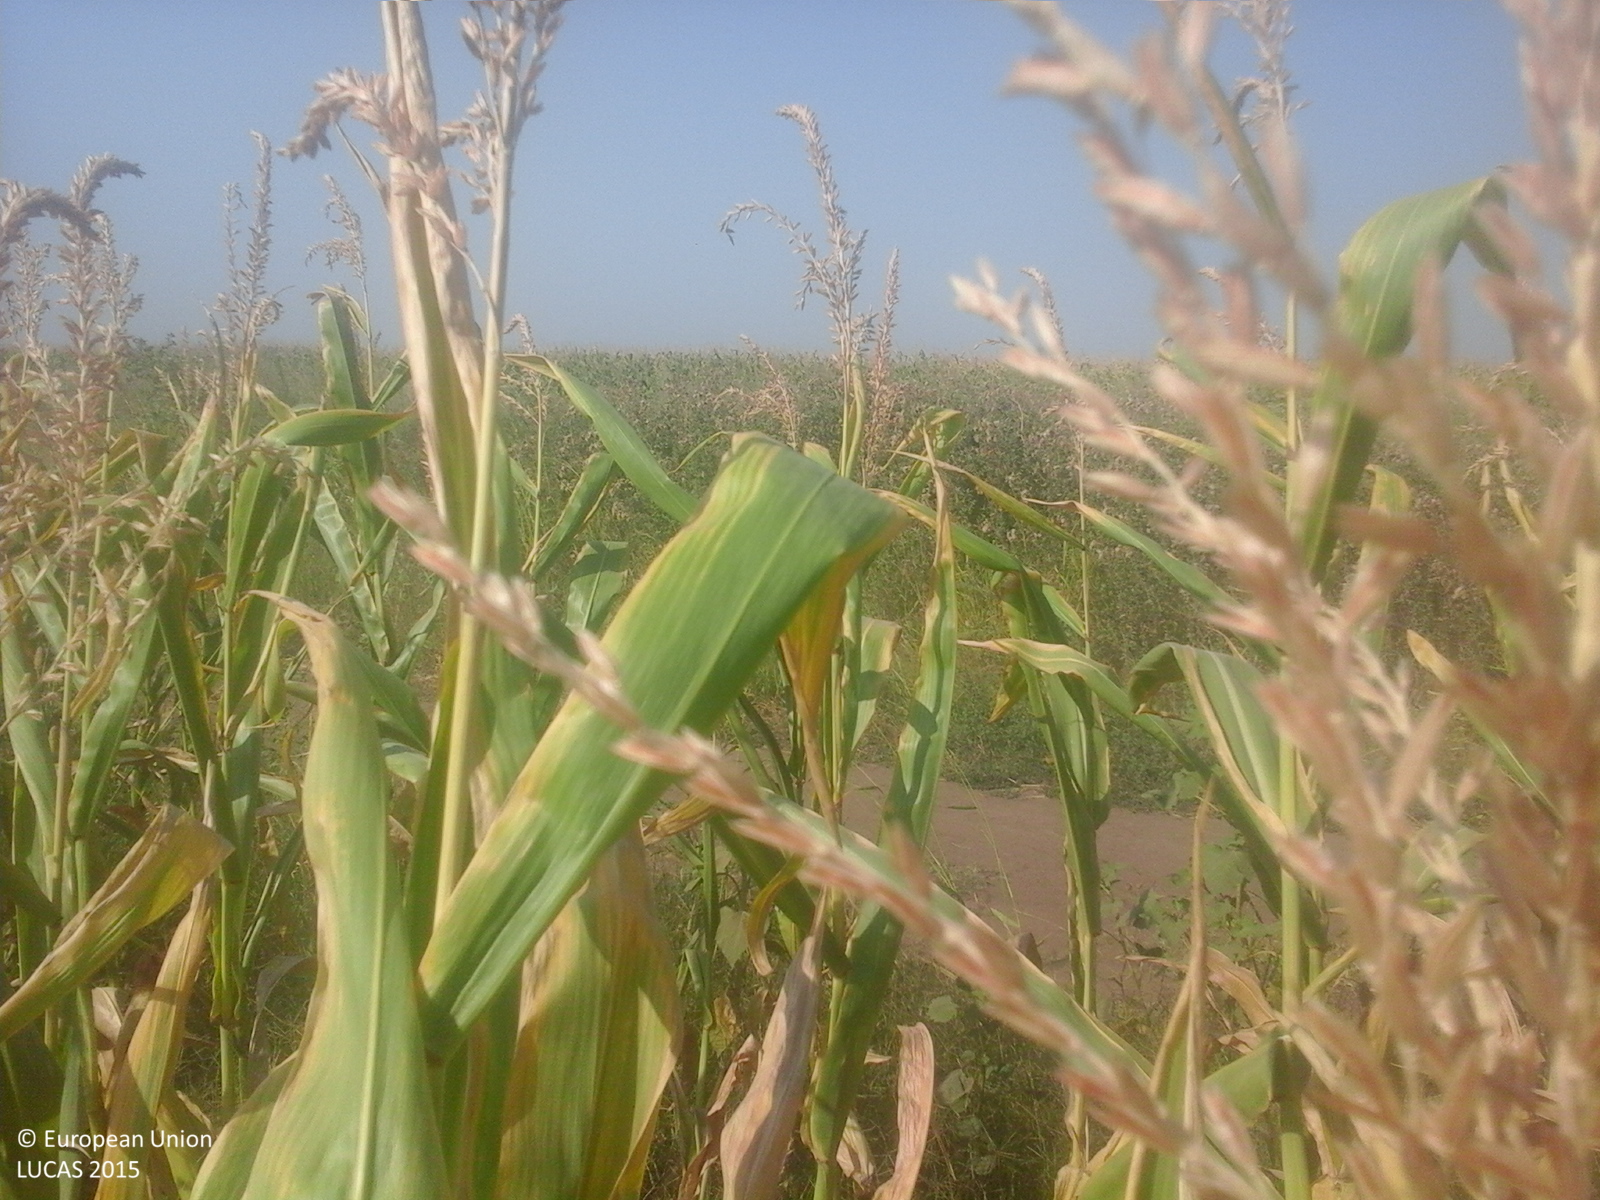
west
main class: Cropland
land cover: Maize
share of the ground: > 75 %
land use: Agriculture (excluding fallow land and kitchen gardens)
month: August
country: RO
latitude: 45.0974
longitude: 27.4949
